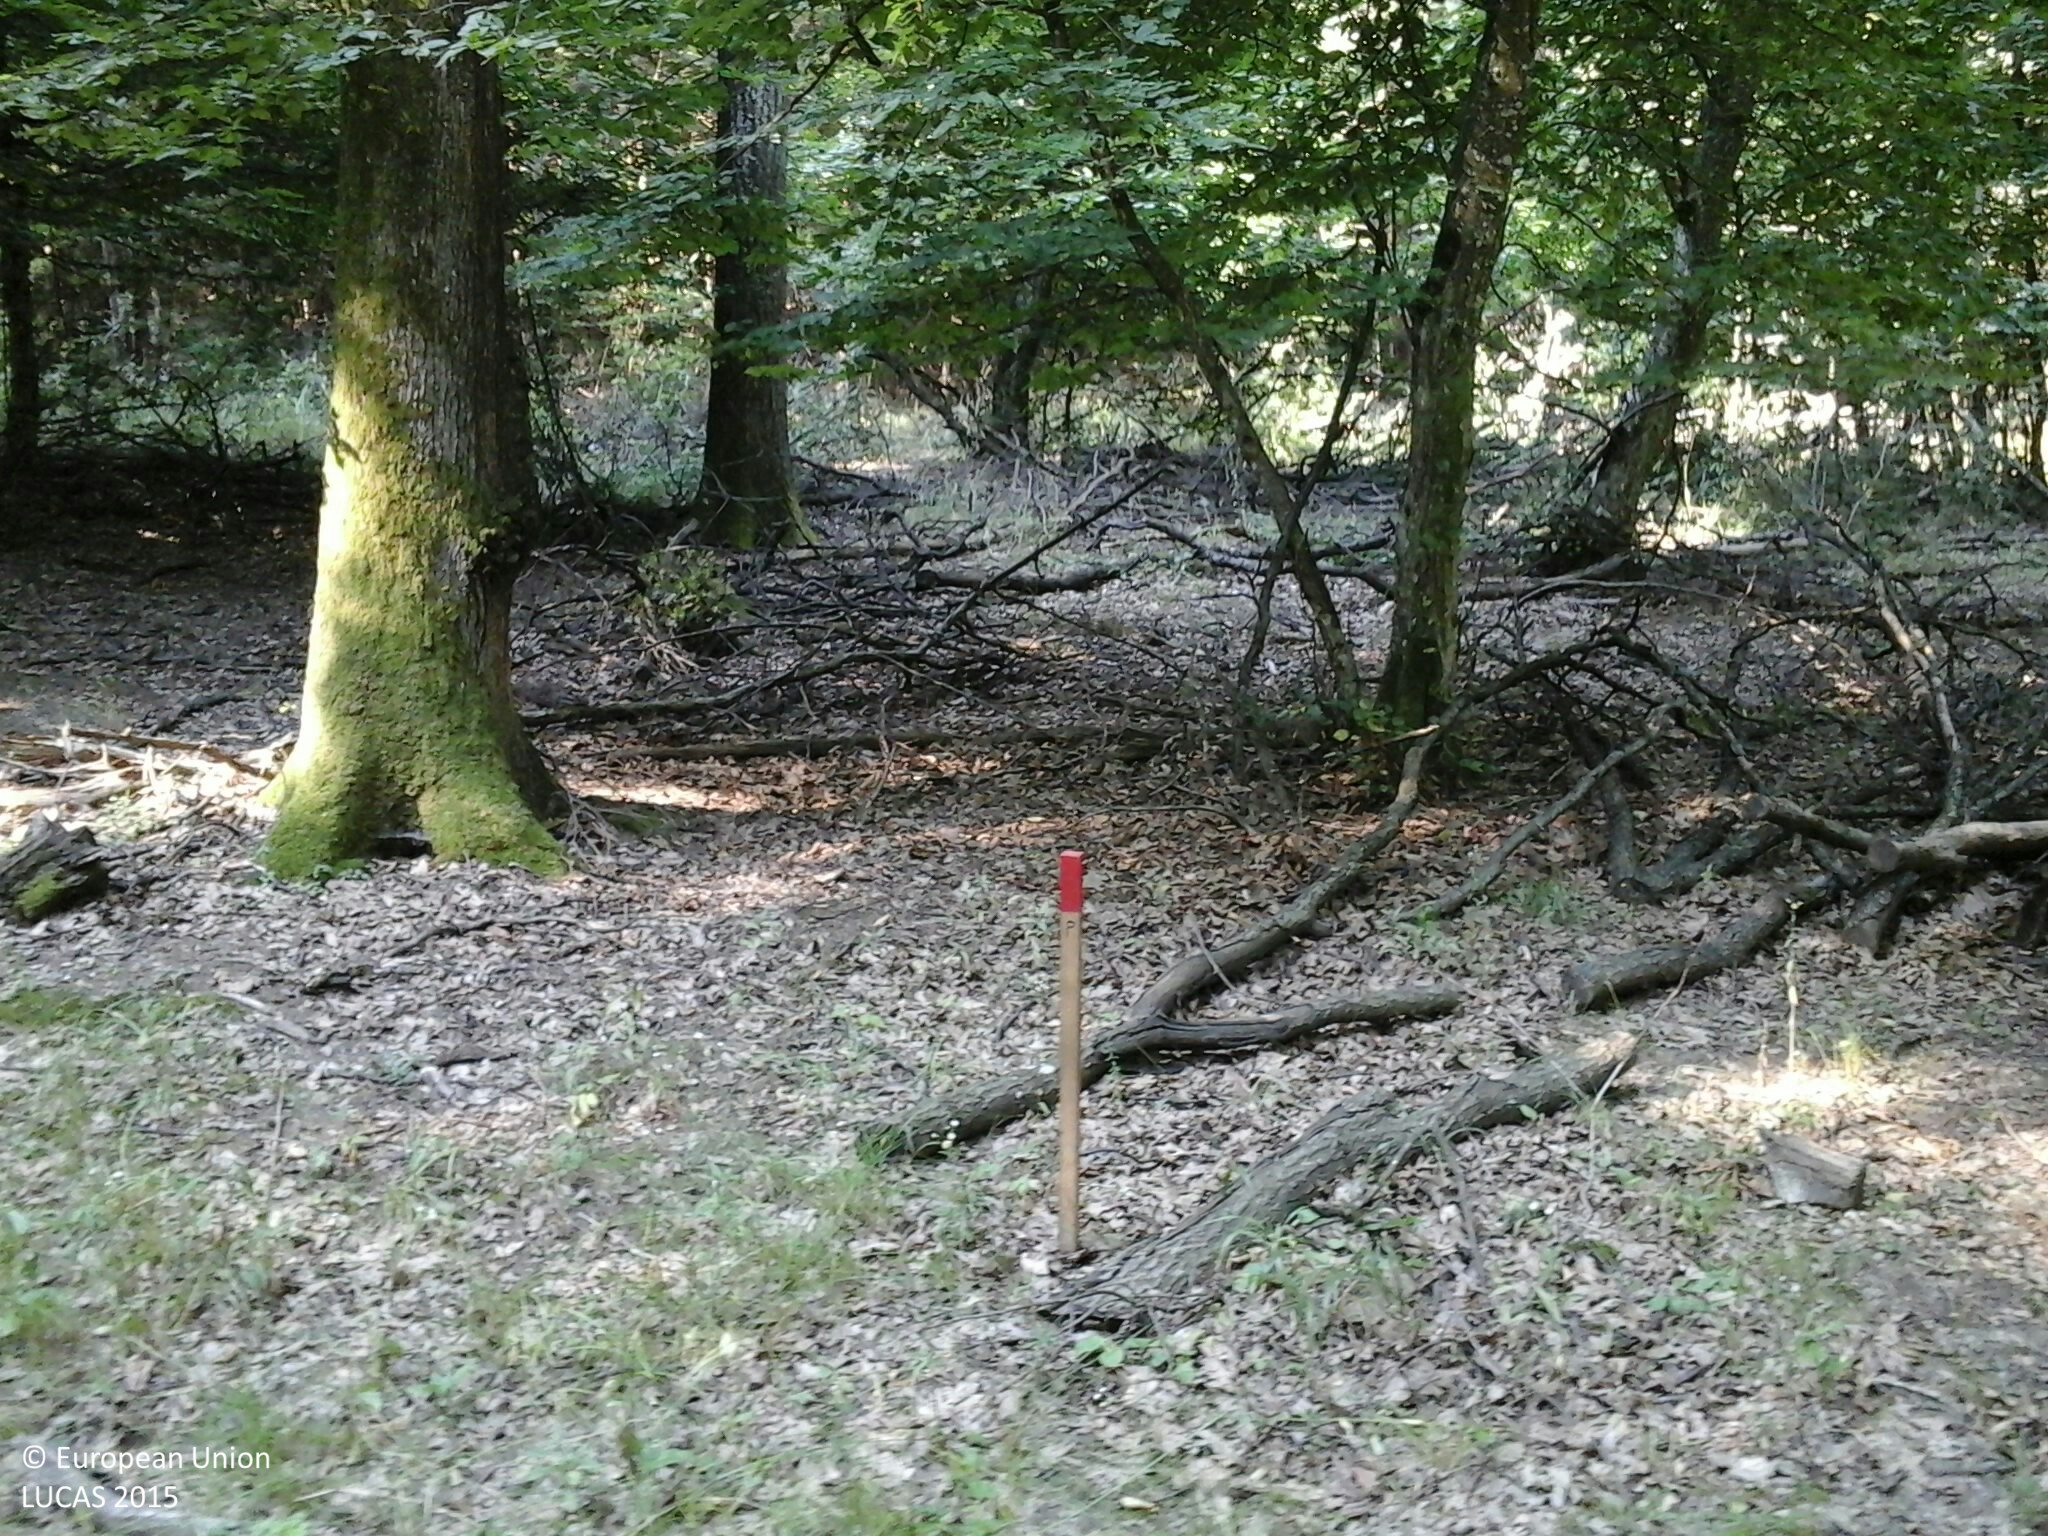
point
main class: Woodland
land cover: Broadleaved woodland
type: beech forest
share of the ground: > 75 %
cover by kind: broadleaved forest trees 95 %, shrubs 5 %
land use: Forestry
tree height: > 5 m
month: July
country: HU
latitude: 46.7249
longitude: 16.6097
